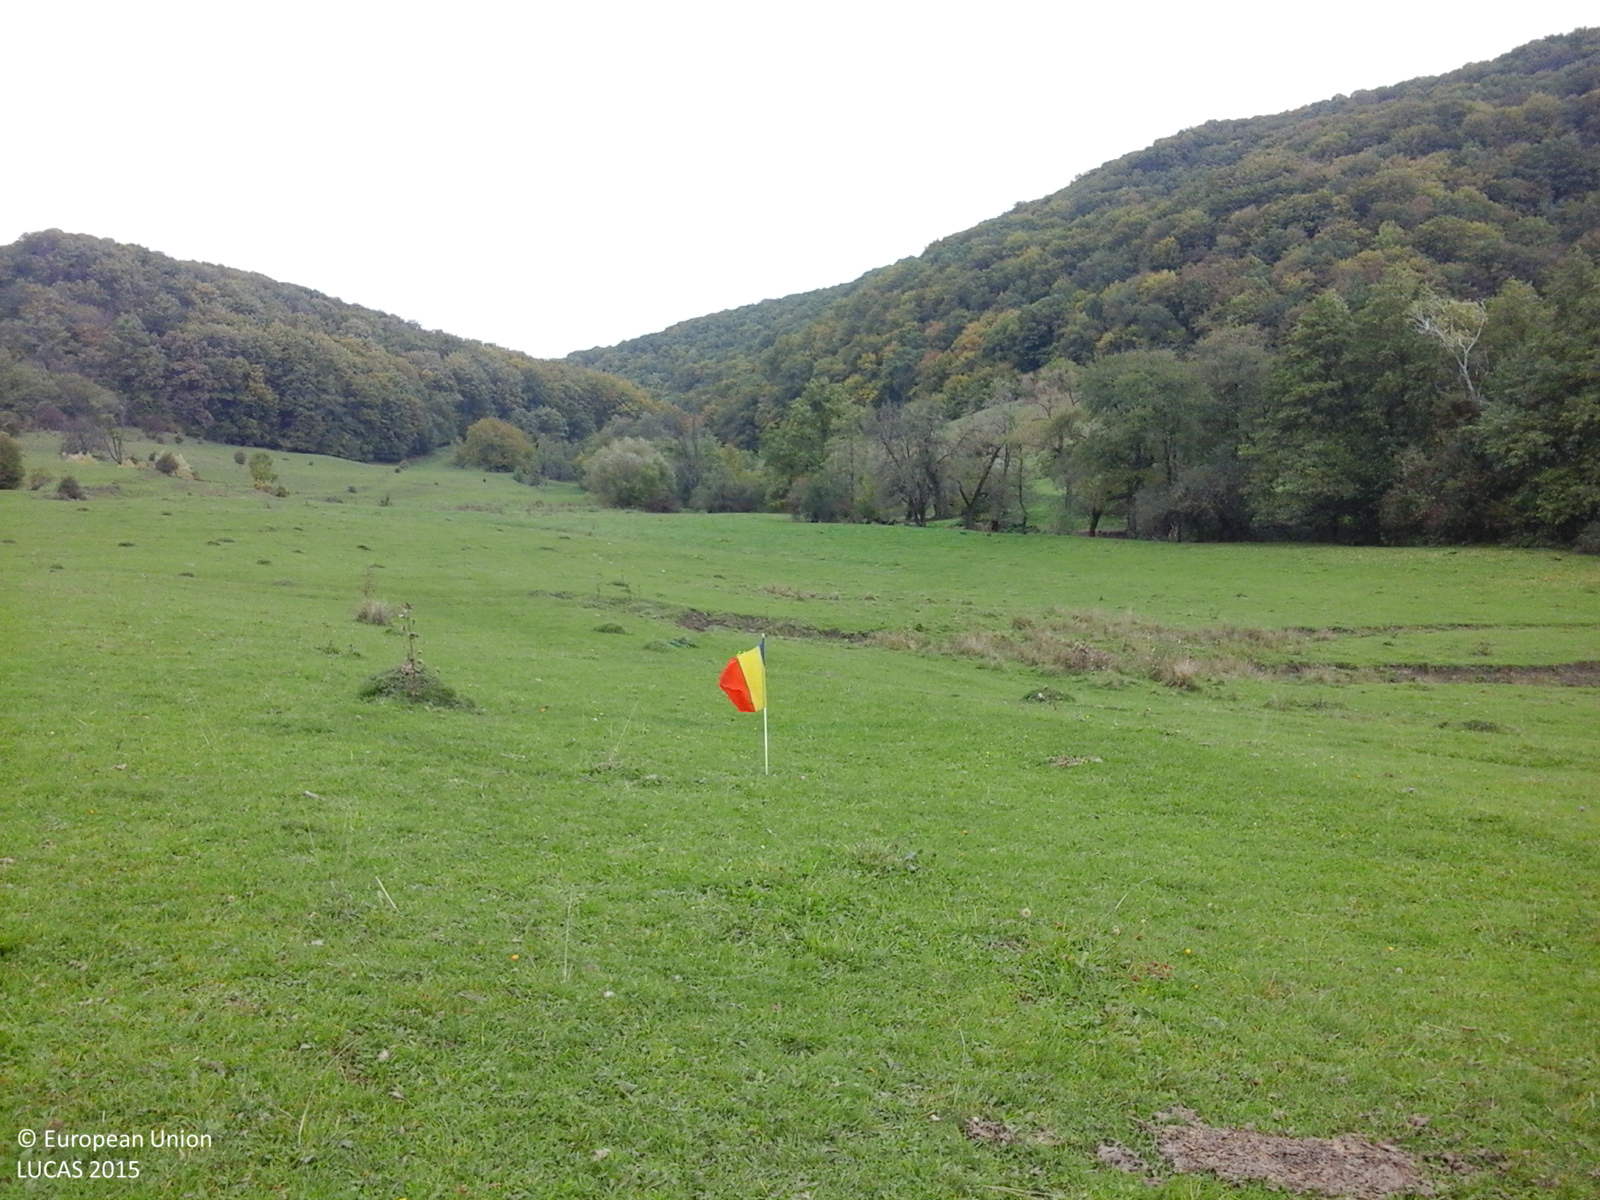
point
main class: Grassland
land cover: Grassland without tree/shrub cover
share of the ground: > 75 %
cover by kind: herbaceous plants 100 %
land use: Agriculture (excluding fallow land and kitchen gardens)
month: October
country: RO
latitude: 46.3859
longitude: 25.1178
